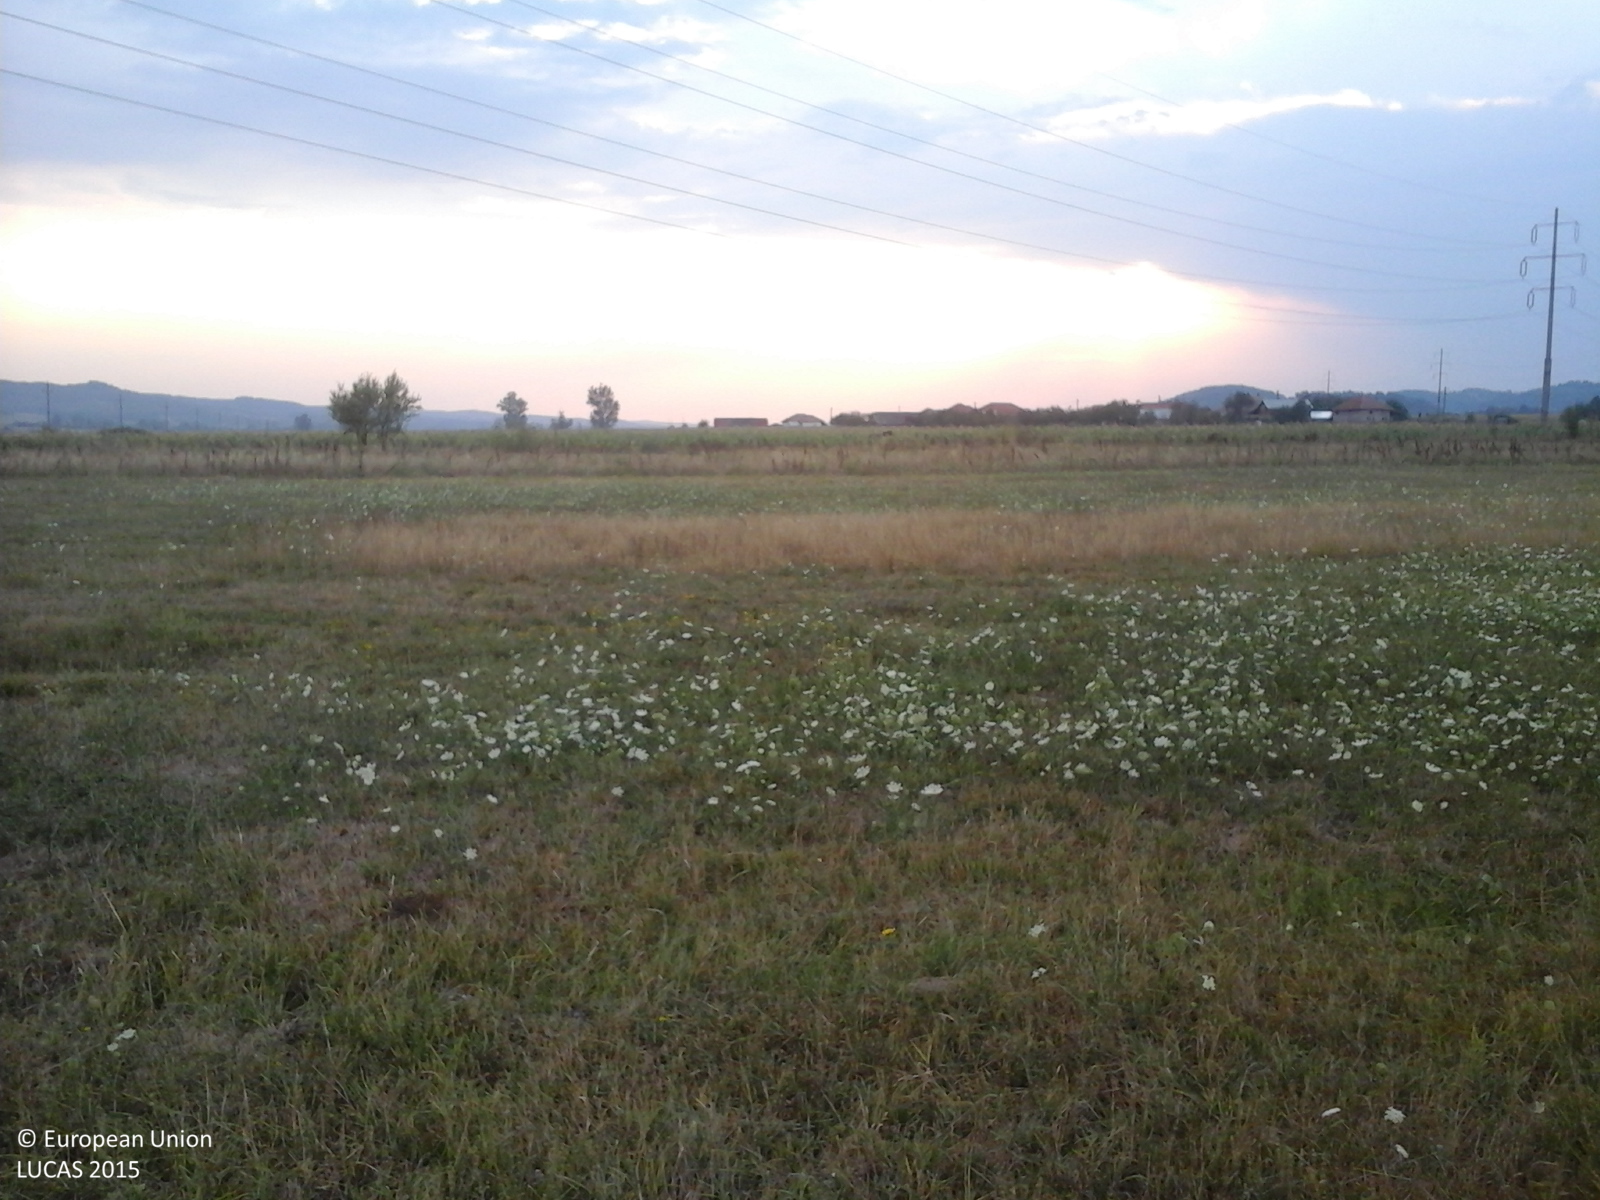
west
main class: Grassland
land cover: Grassland without tree/shrub cover
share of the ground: > 75 %
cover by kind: herbaceous plants 100 %
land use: Agriculture (excluding fallow land and kitchen gardens)
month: August
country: RO
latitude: 44.6927
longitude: 23.0320
